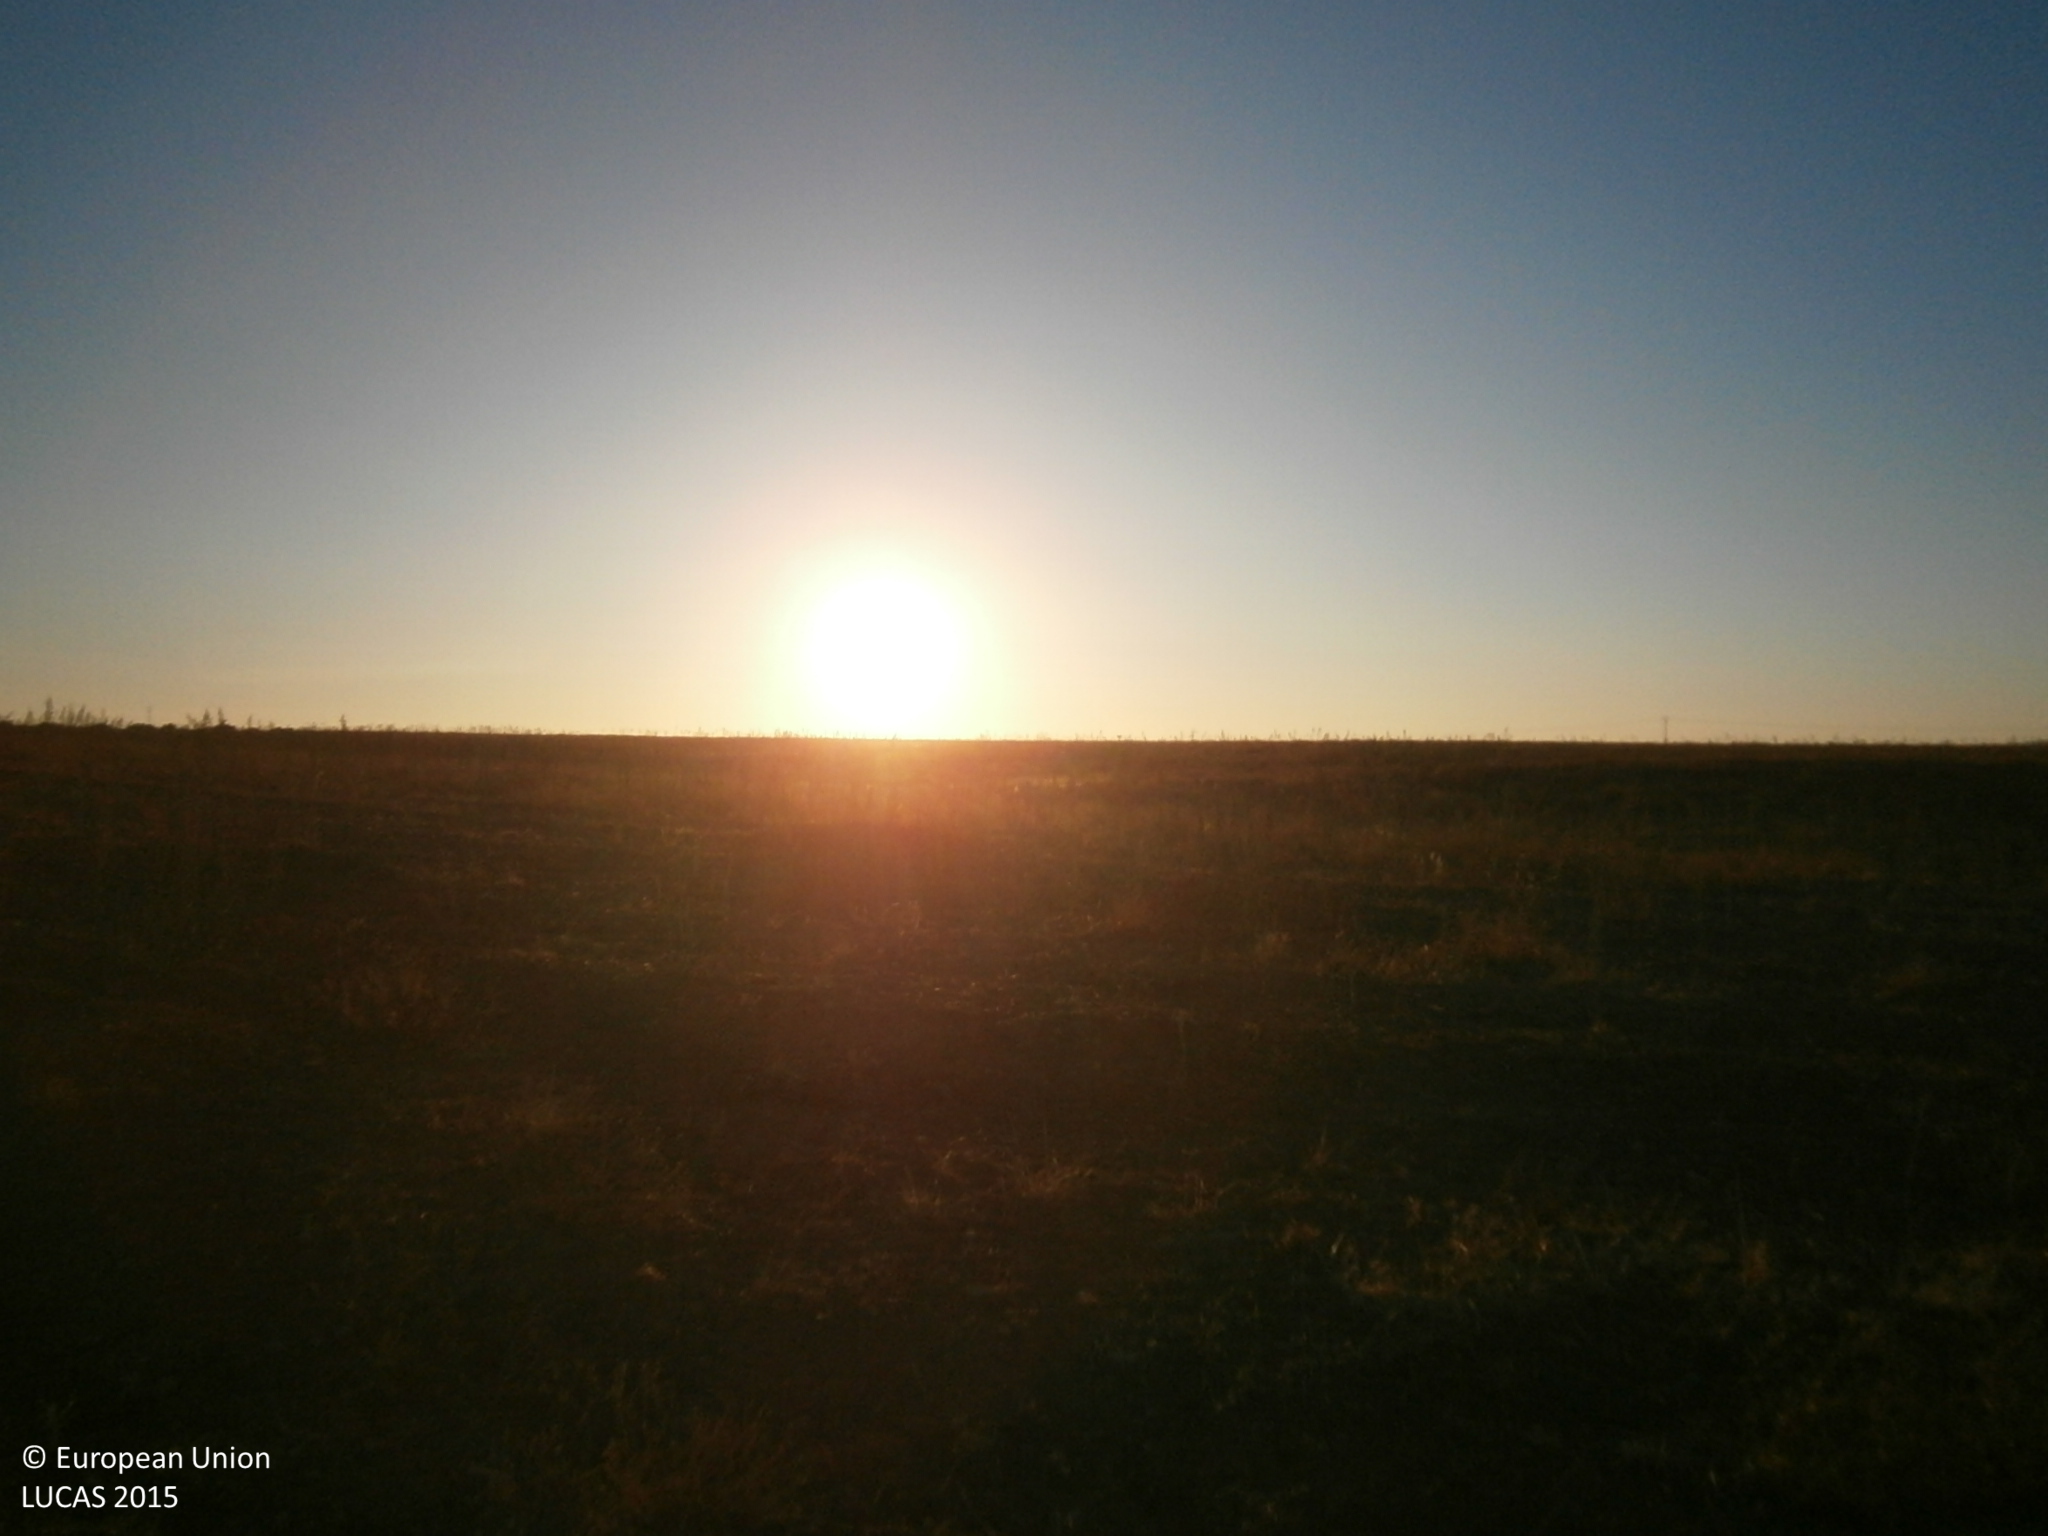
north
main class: Grassland
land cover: Spontaneously vegetated surfaces
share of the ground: > 75 %
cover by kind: herbaceous plants 80 %, unconsolidated bare surface 15 %
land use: Agriculture (excluding fallow land and kitchen gardens)
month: July
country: ES
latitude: 38.6782
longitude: -7.2100
